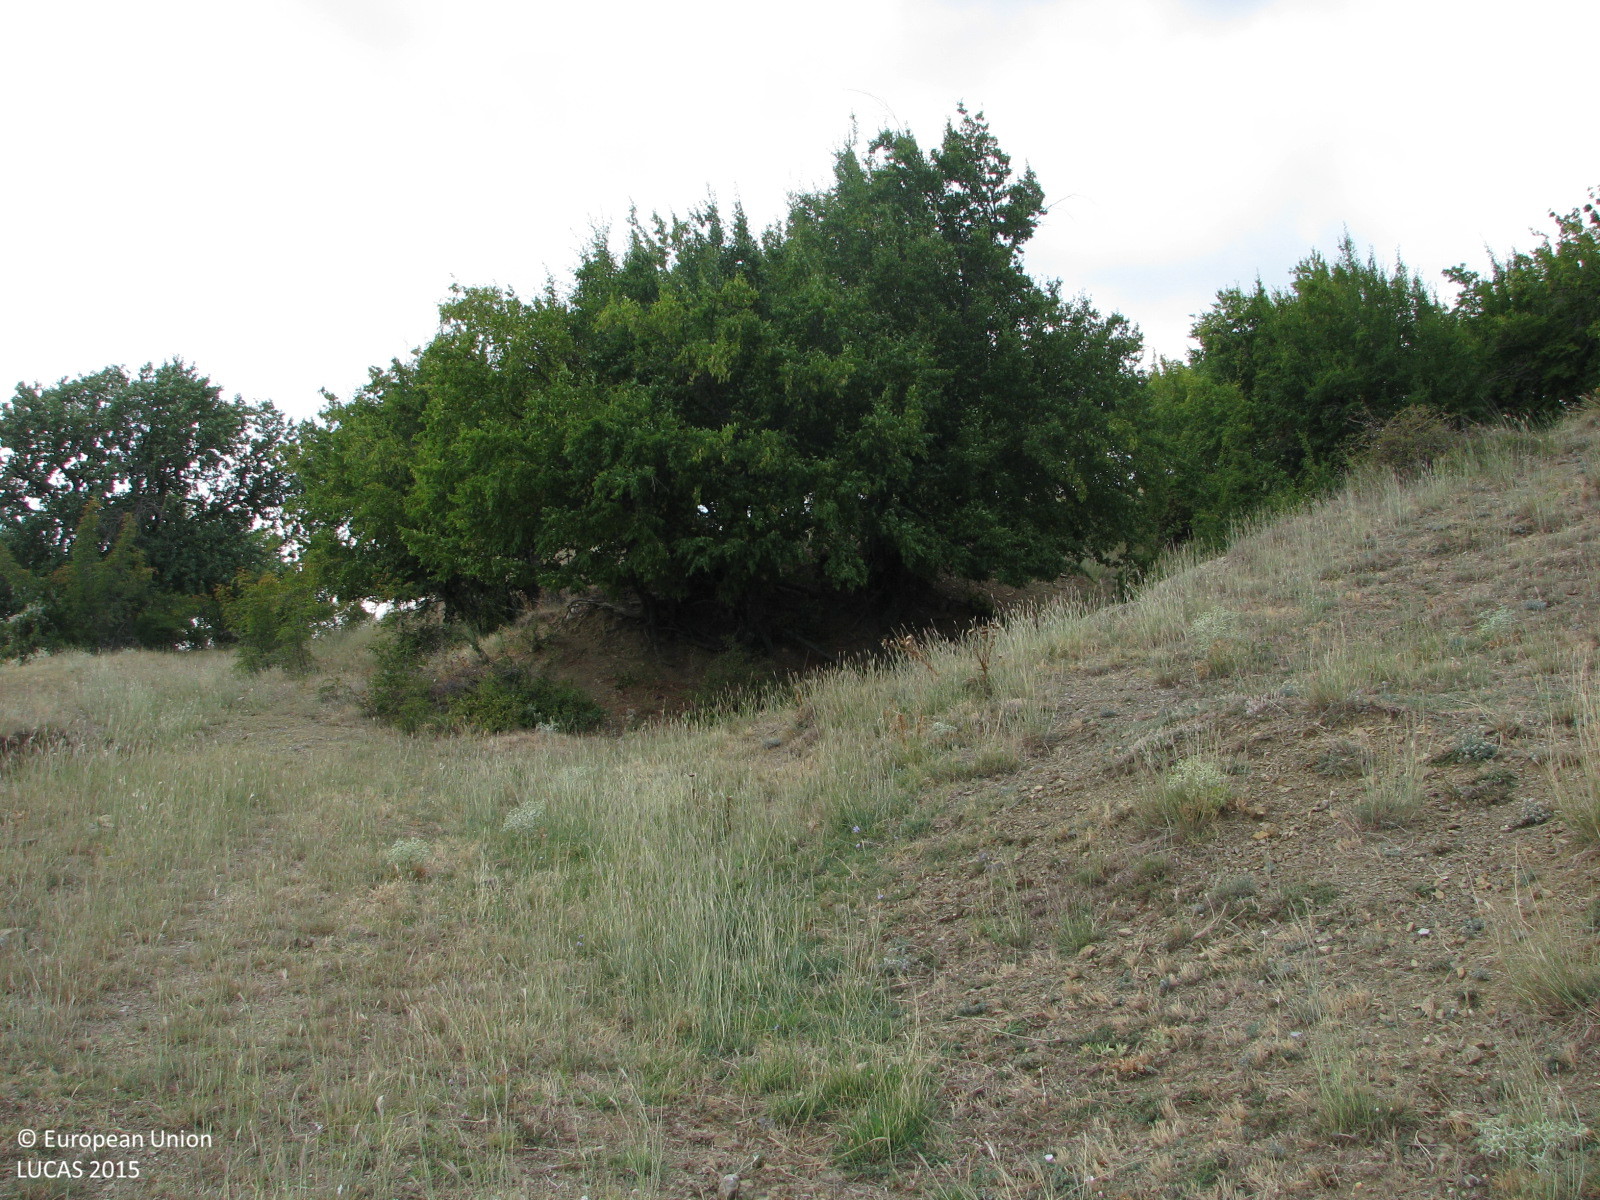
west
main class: Grassland
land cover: Grassland with sparse tree/shrub cover
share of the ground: > 75 %
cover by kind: herbaceous plants 85 %, shrubs 10 %, broadleaved forest trees 5 %
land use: Agriculture (excluding fallow land and kitchen gardens)
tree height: < 5 m
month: August
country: BG
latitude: 42.5525
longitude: 25.9741
